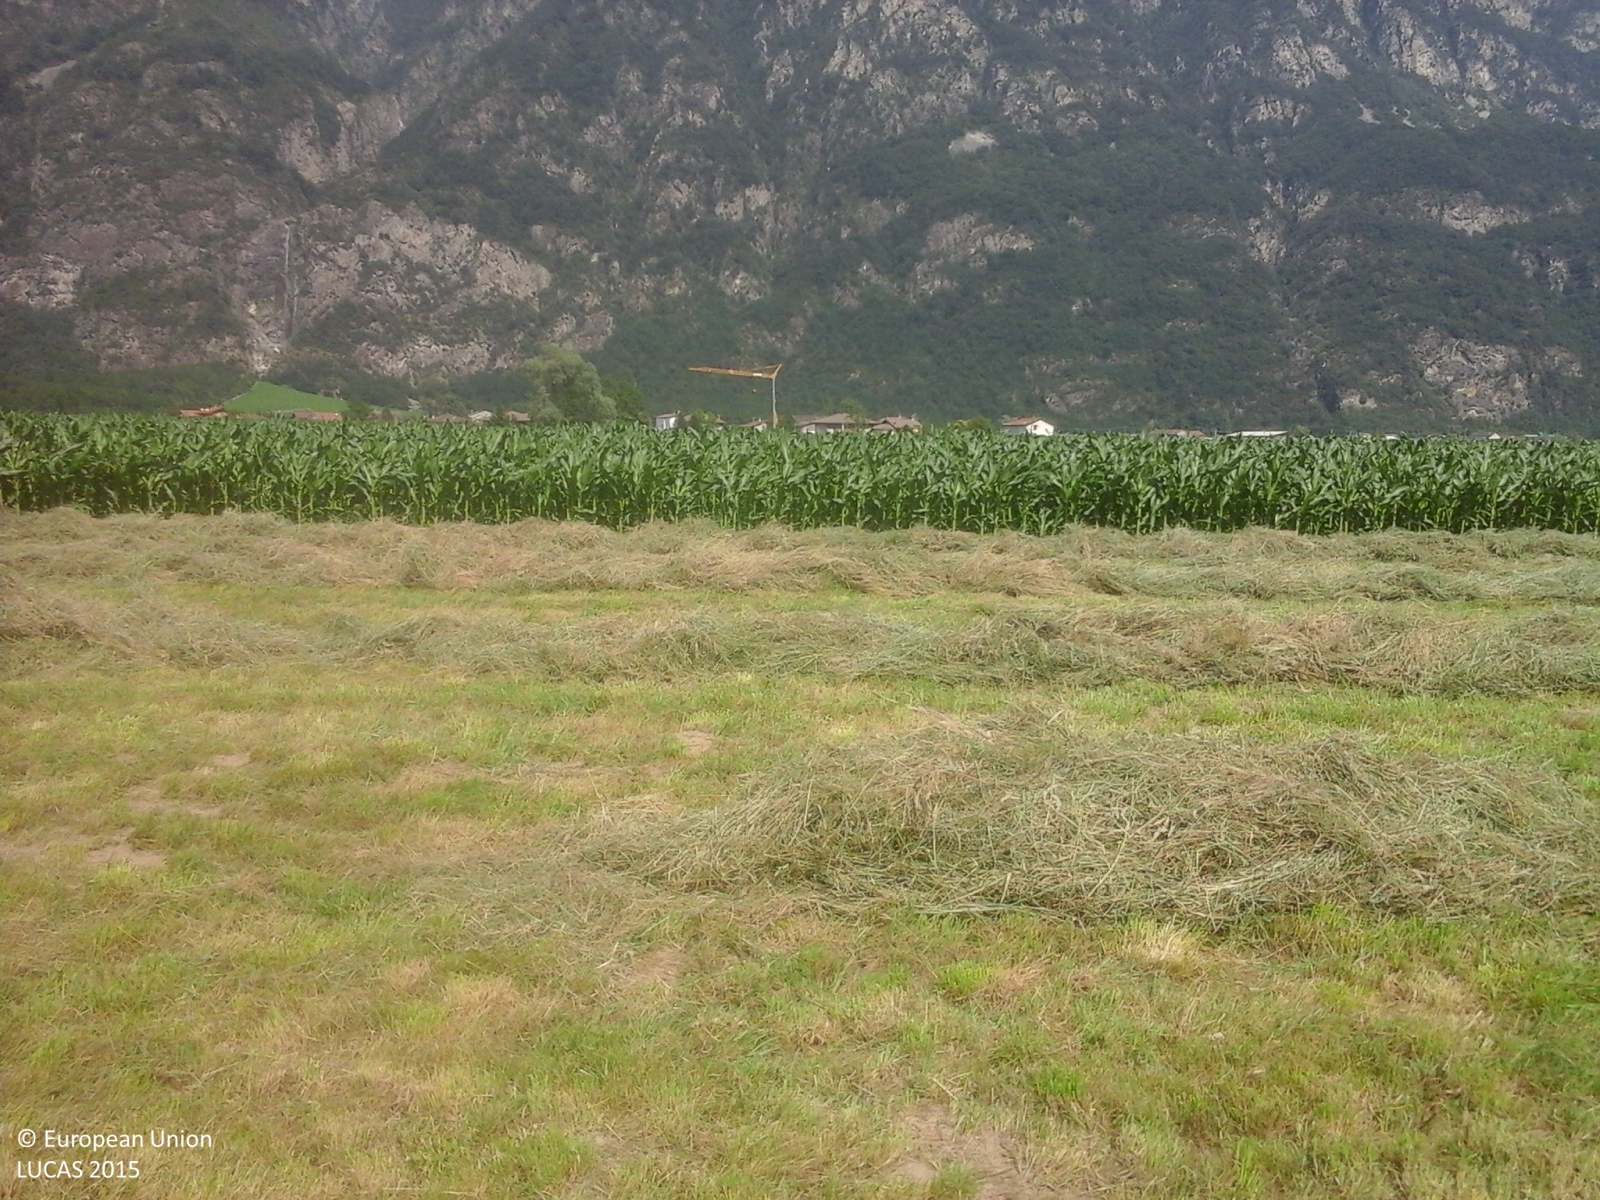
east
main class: Grassland
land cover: Grassland without tree/shrub cover
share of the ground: > 75 %
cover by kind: herbaceous plants 100 %
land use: Agriculture (excluding fallow land and kitchen gardens)
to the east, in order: Grassland without tree/shrub cover; Maize
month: July
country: IT
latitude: 46.2415
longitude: 9.4172
